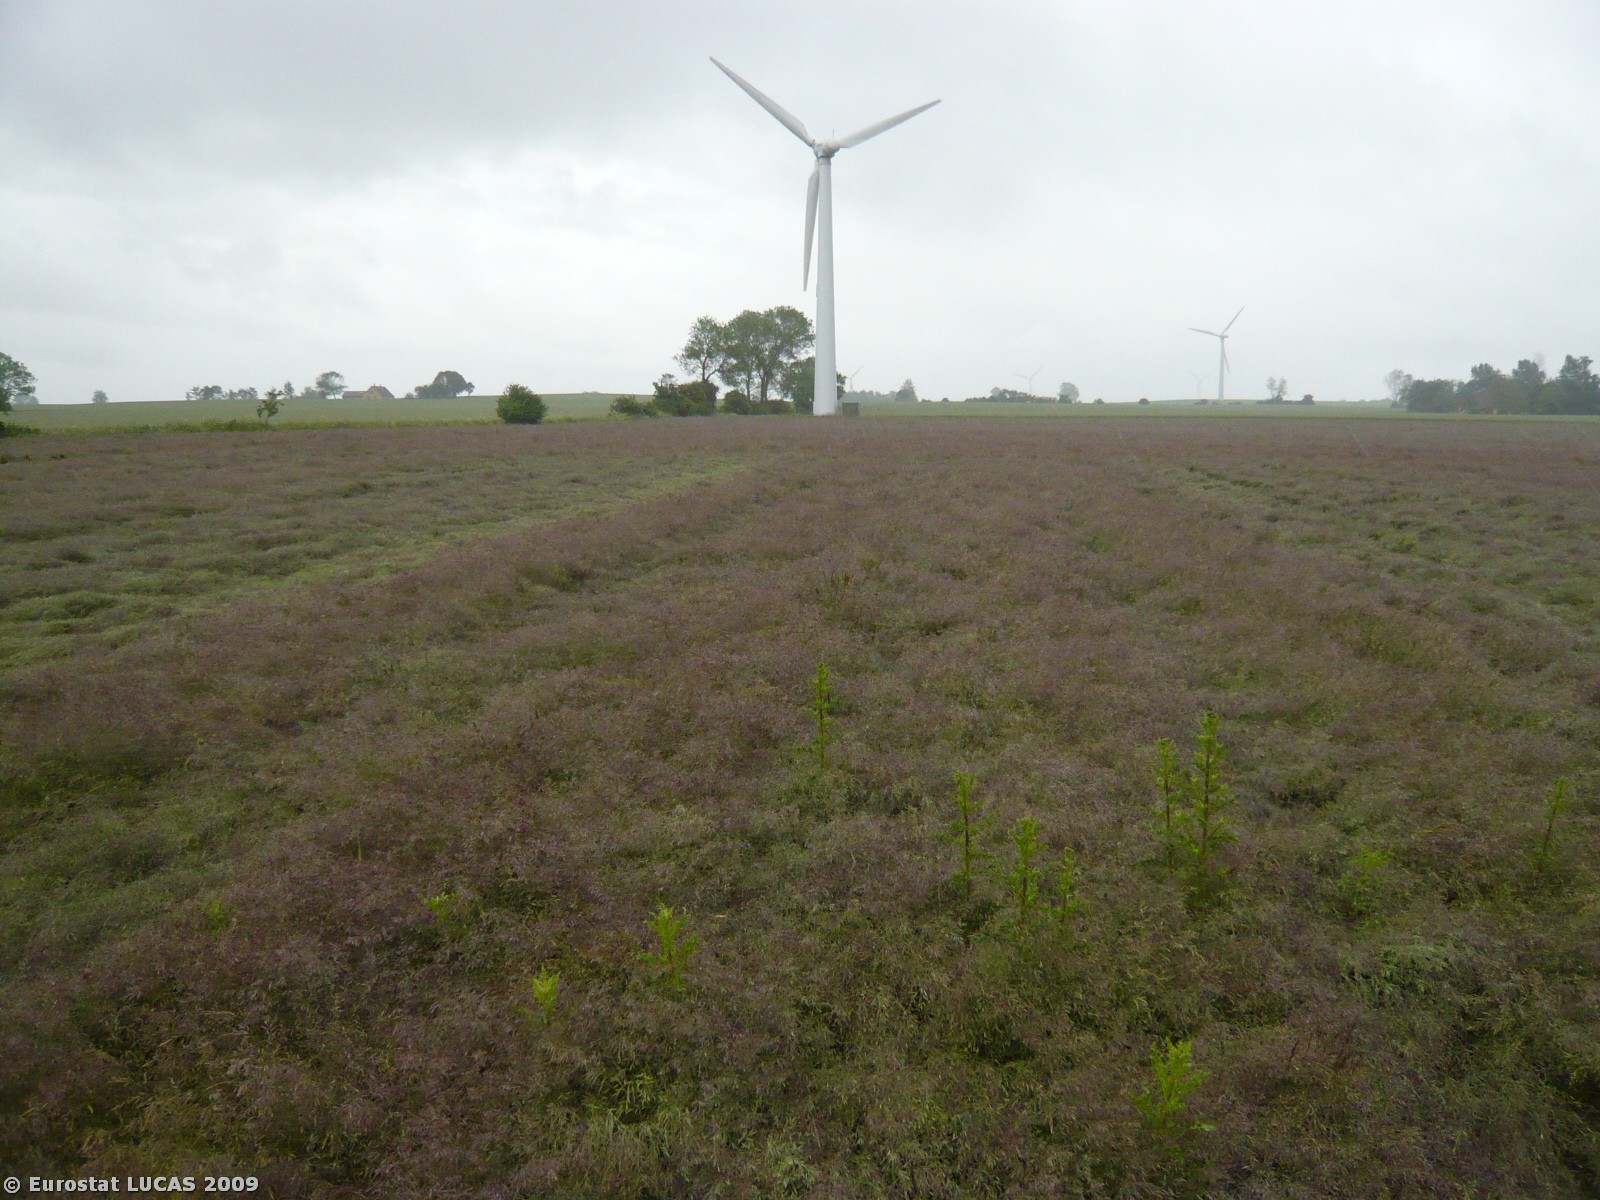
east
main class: Cropland
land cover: Temporary grasslands
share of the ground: > 75 %
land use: Agriculture (excluding fallow land and kitchen gardens)
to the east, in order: Temporary grasslands; Artificial constructions; Common wheat
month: June
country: DK
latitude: 54.6638
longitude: 11.8748
